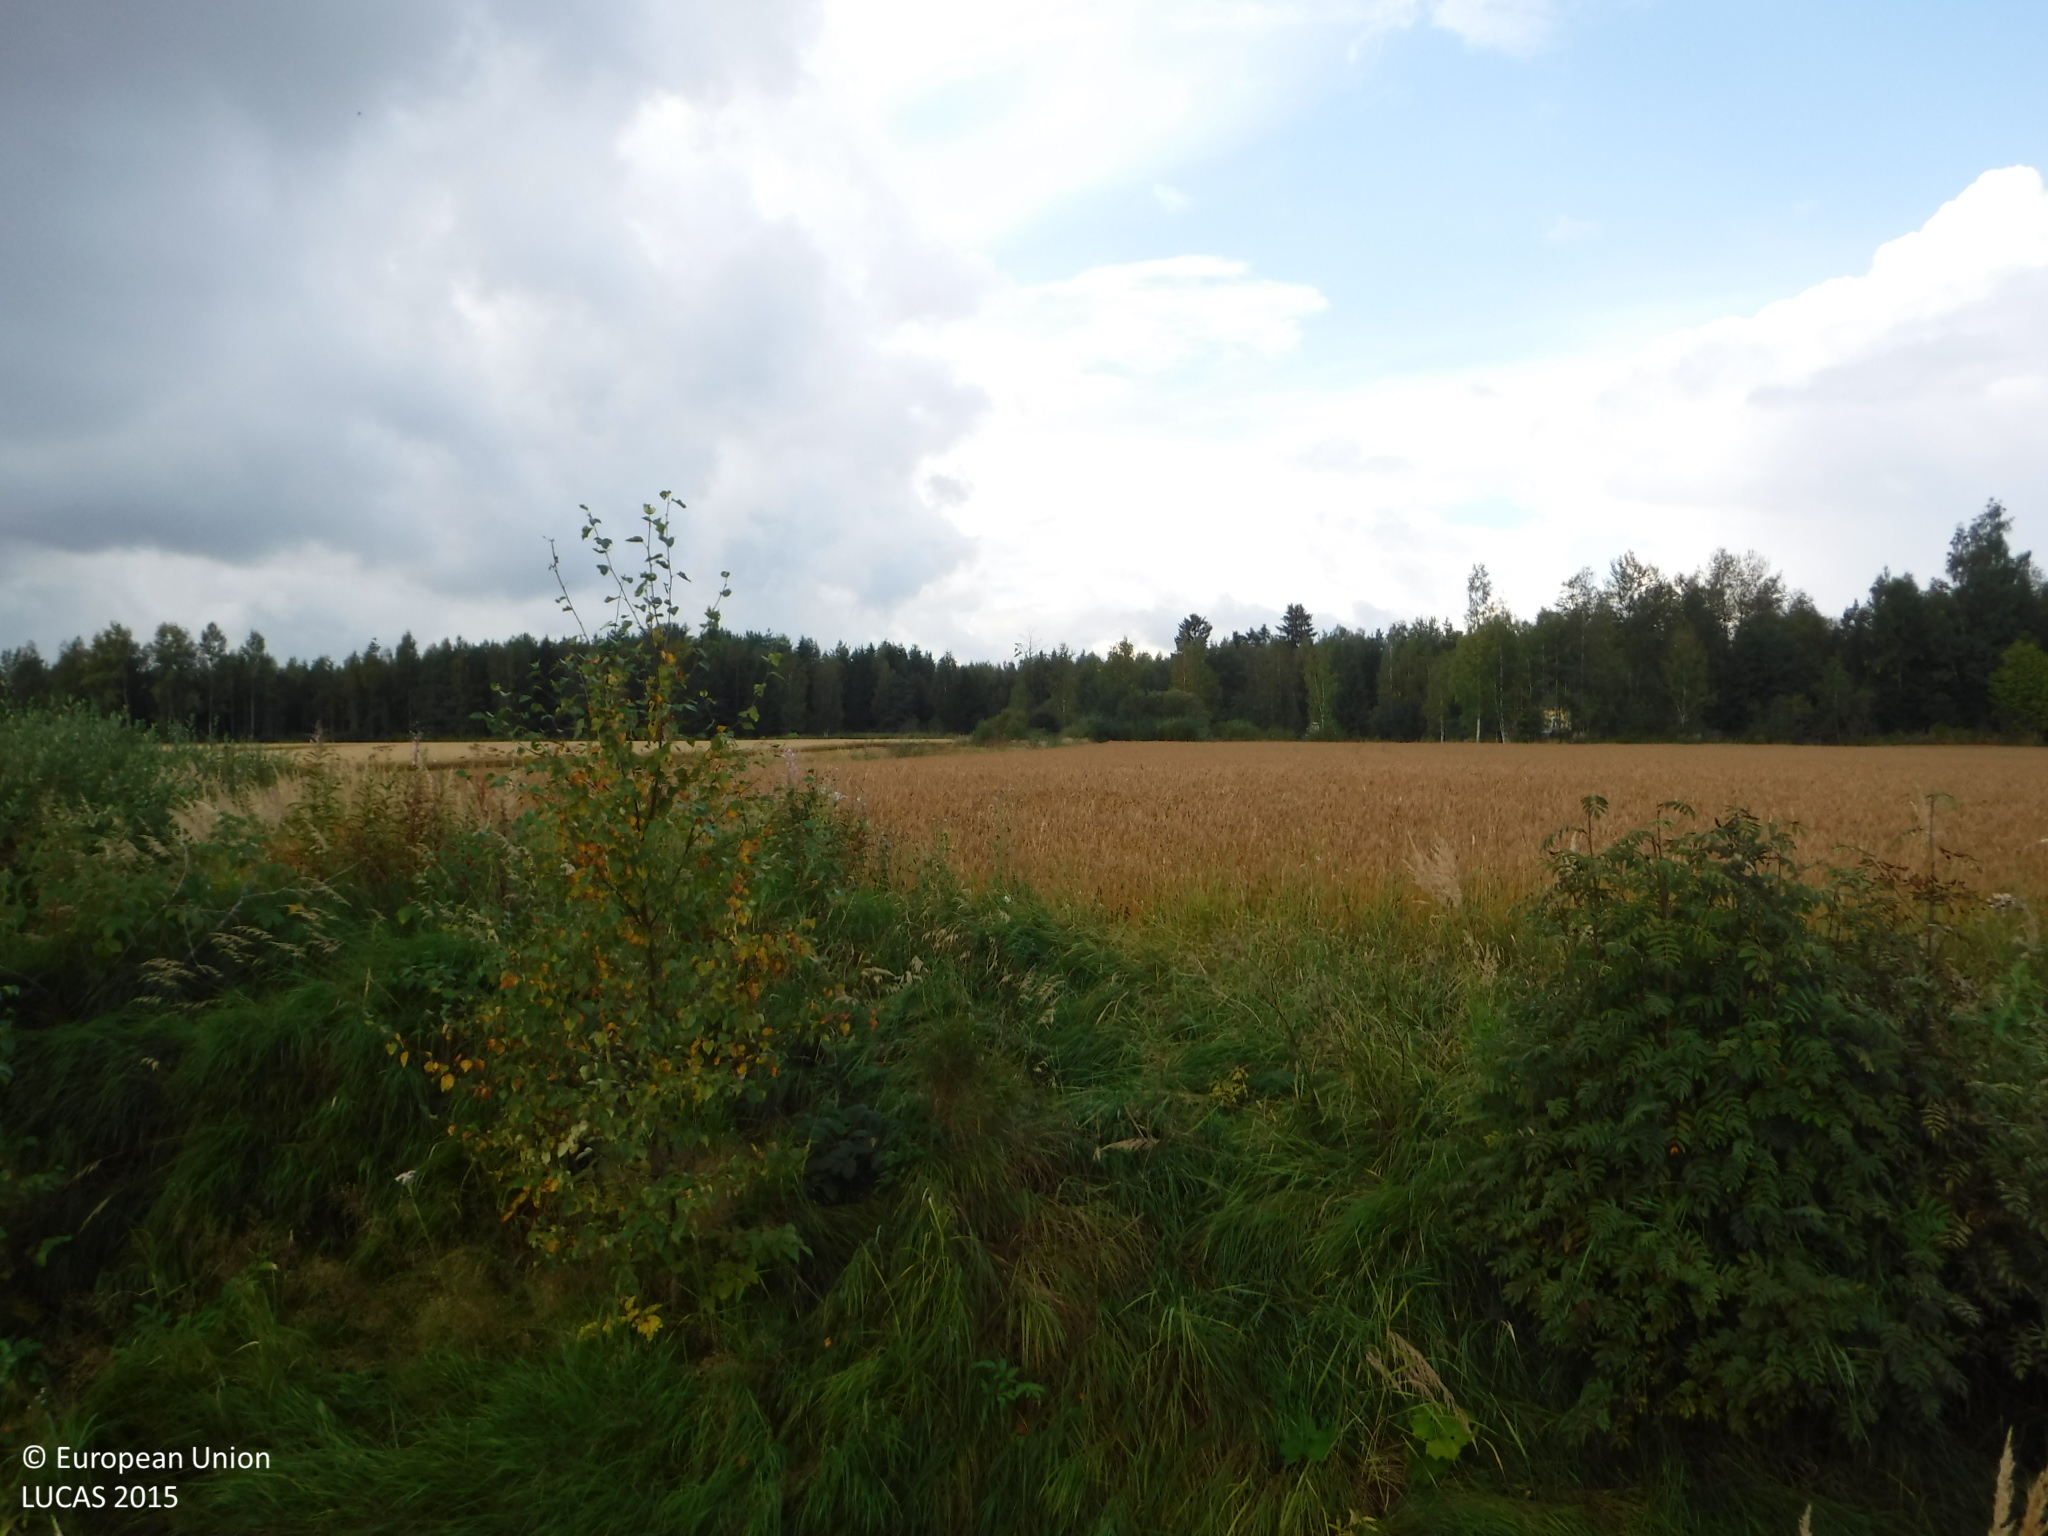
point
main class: Cropland
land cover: Common wheat
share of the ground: > 75 %
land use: Agriculture (excluding fallow land and kitchen gardens)
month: September
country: FI
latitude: 61.3189
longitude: 22.5235
